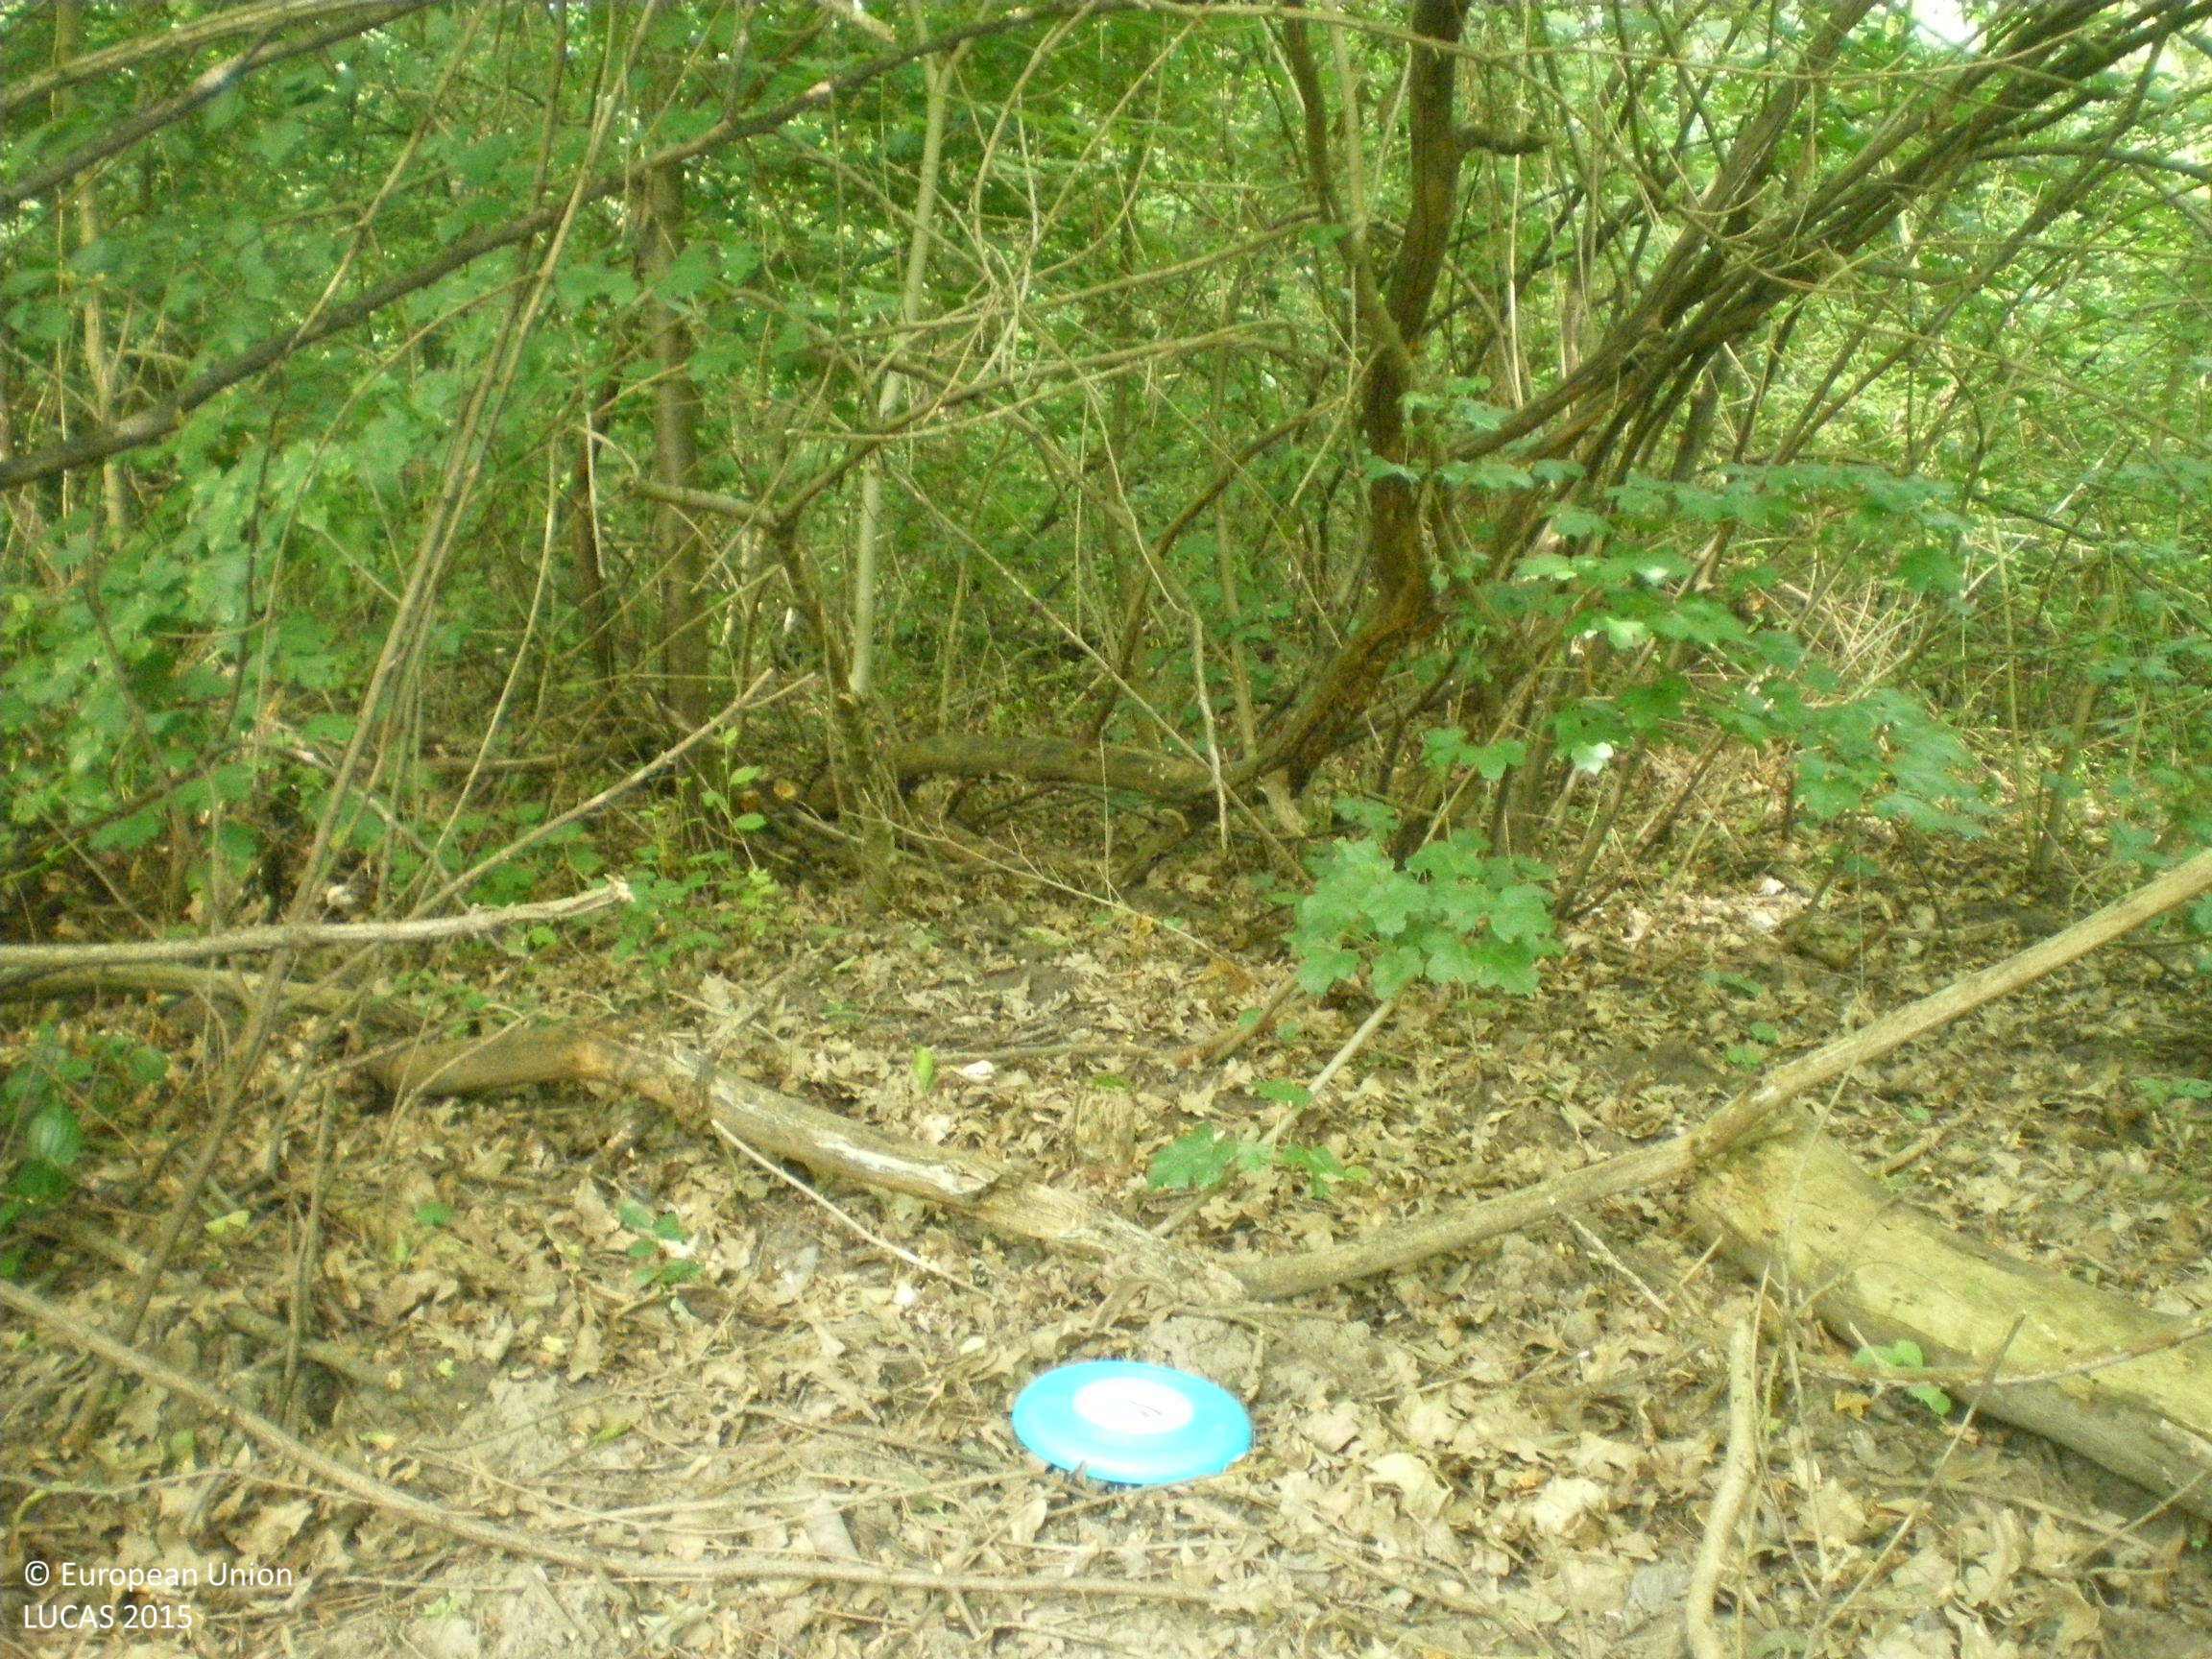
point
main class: Woodland
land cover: Broadleaved woodland
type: mesophytic deciduous forest
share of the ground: > 75 %
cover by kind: broadleaved forest trees 90 %, shrubs 10 %
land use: Forestry
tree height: > 5 m
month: June
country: BG
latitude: 42.1453
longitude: 25.1727
